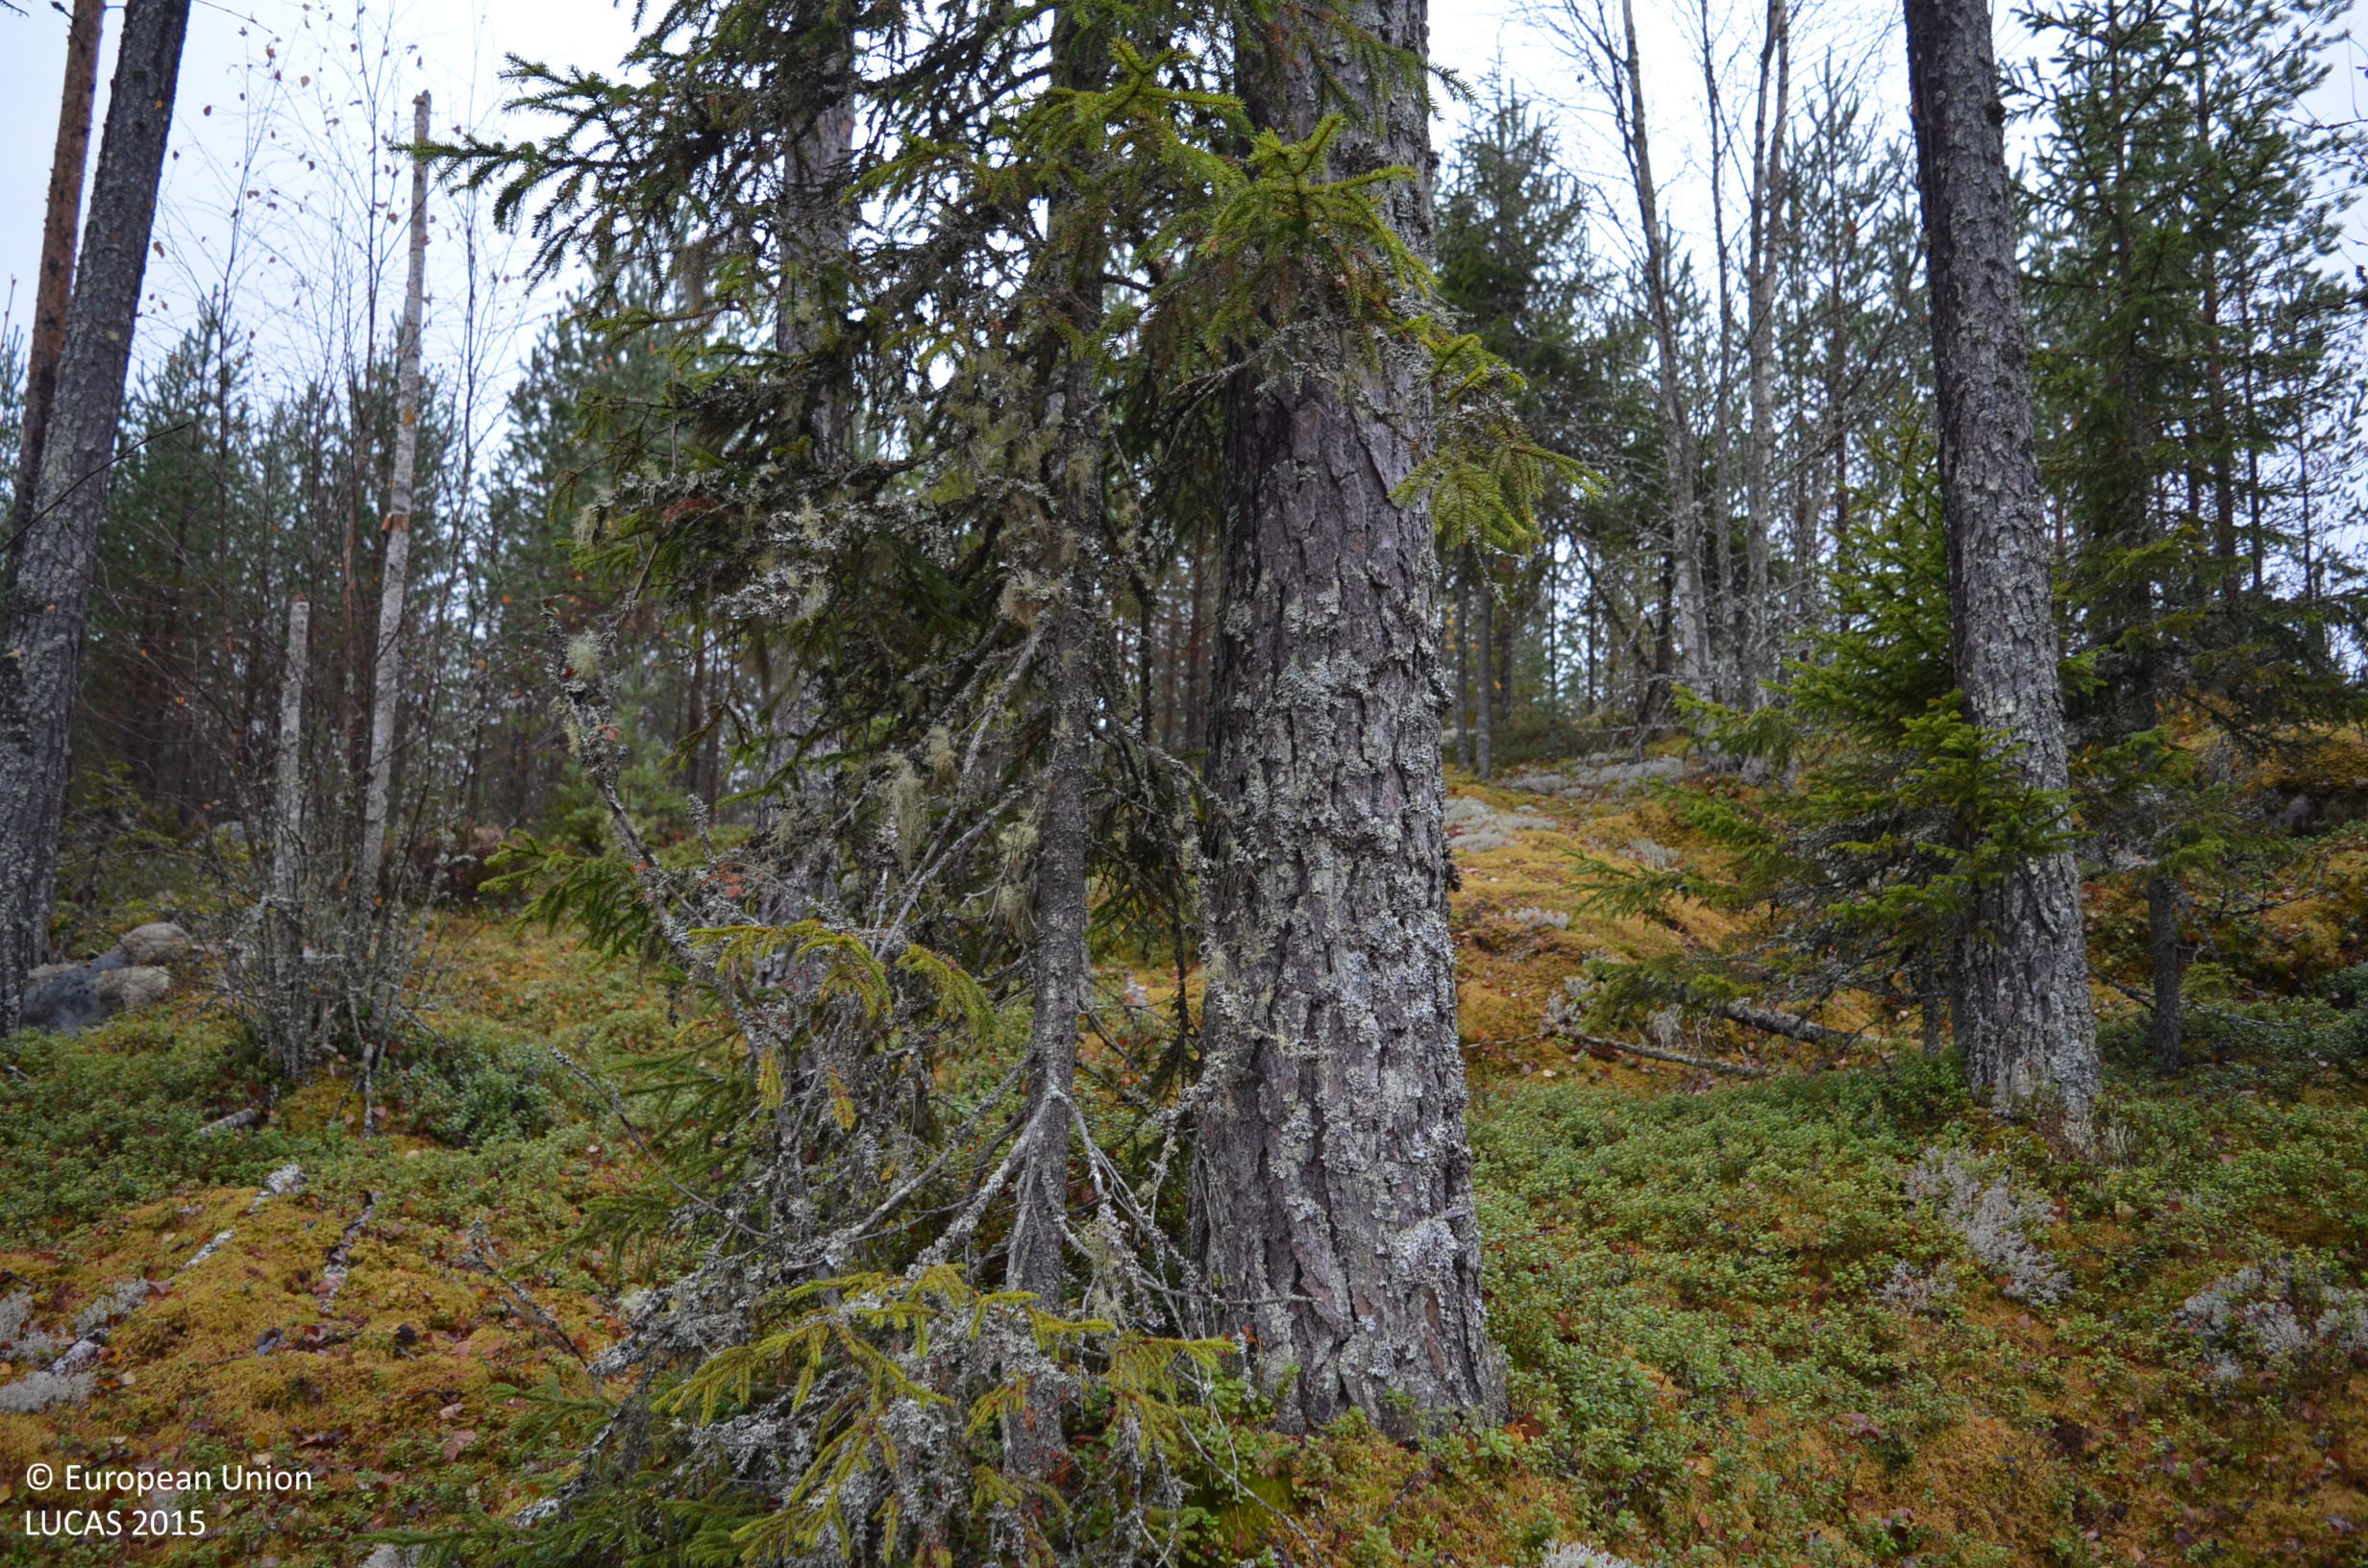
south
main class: Woodland
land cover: Other coniferous woodland
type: boreal forest
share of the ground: 50 - 75 %
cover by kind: coniferous forest trees 50 %, shrubs 15 %, lichens and mosses 15 %, broadleaved forest trees 10 %, consolidated bare surface 10 %
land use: Forestry
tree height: > 5 m
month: October
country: FI
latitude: 62.2441
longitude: 23.6456
